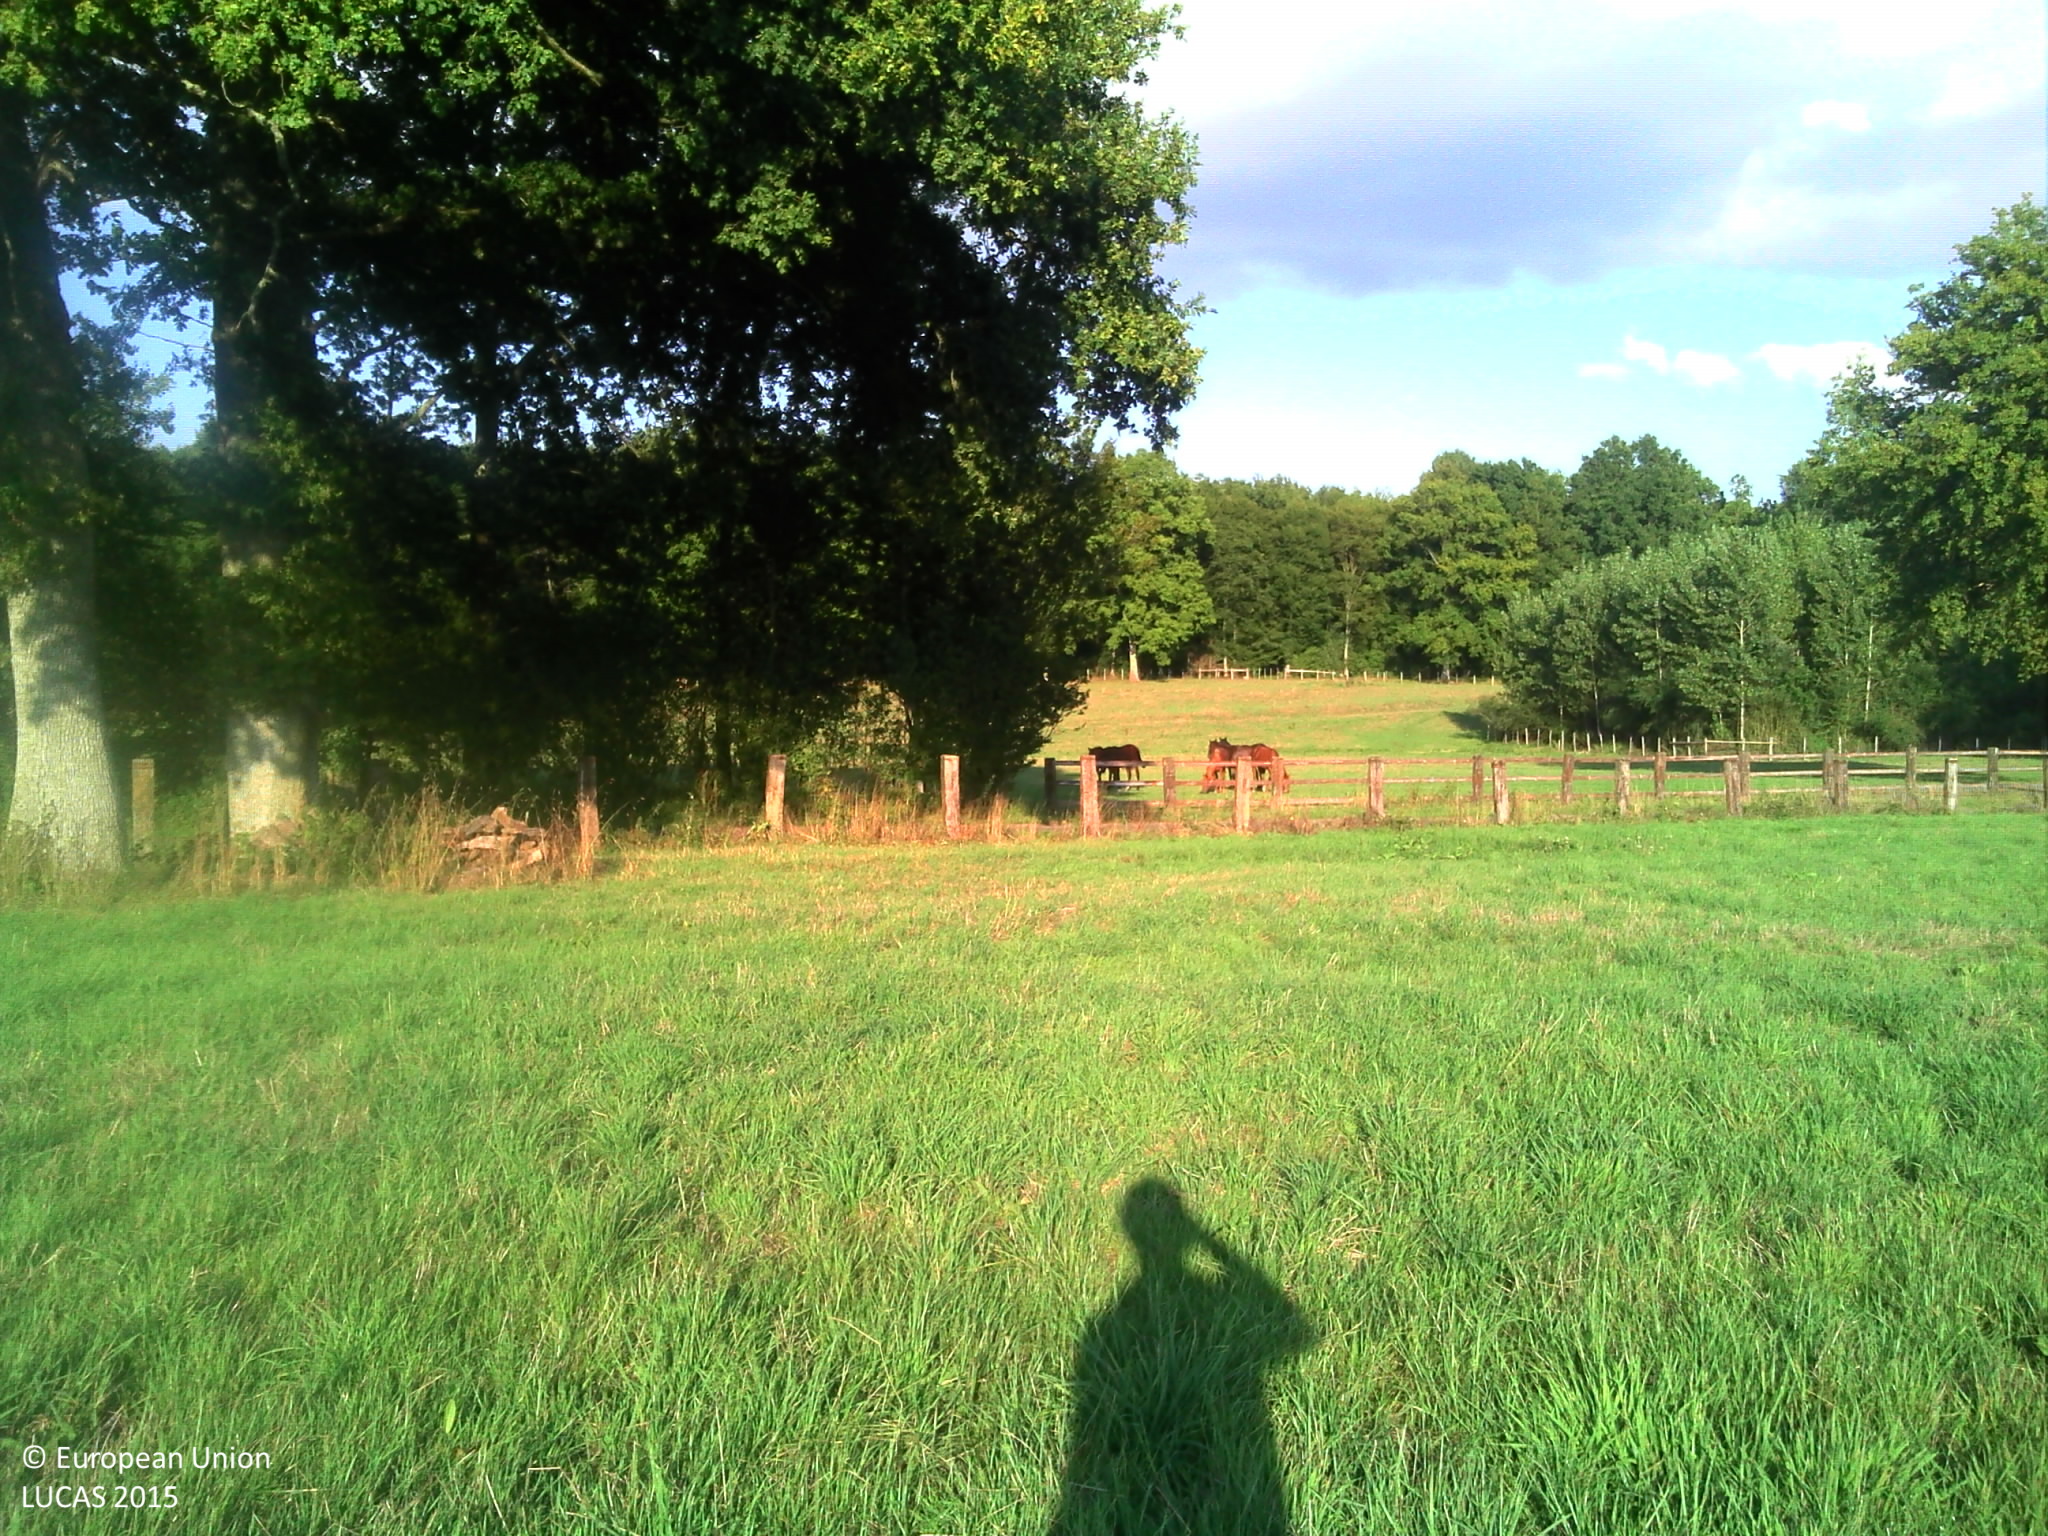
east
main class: Grassland
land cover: Grassland without tree/shrub cover
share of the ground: > 75 %
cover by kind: herbaceous plants 100 %
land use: Agriculture (excluding fallow land and kitchen gardens)
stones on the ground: < 10 %
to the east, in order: Grassland without tree/shrub cover; Broadleaved woodland; Fences; Ditches and canals; Grass margins; Paved roads, cycling and walking lanes; Grass margins; Fences; Grassland without tree/shrub cover; Fences; Broadleaved woodland
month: September
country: FR
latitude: 48.4107
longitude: 0.5049
